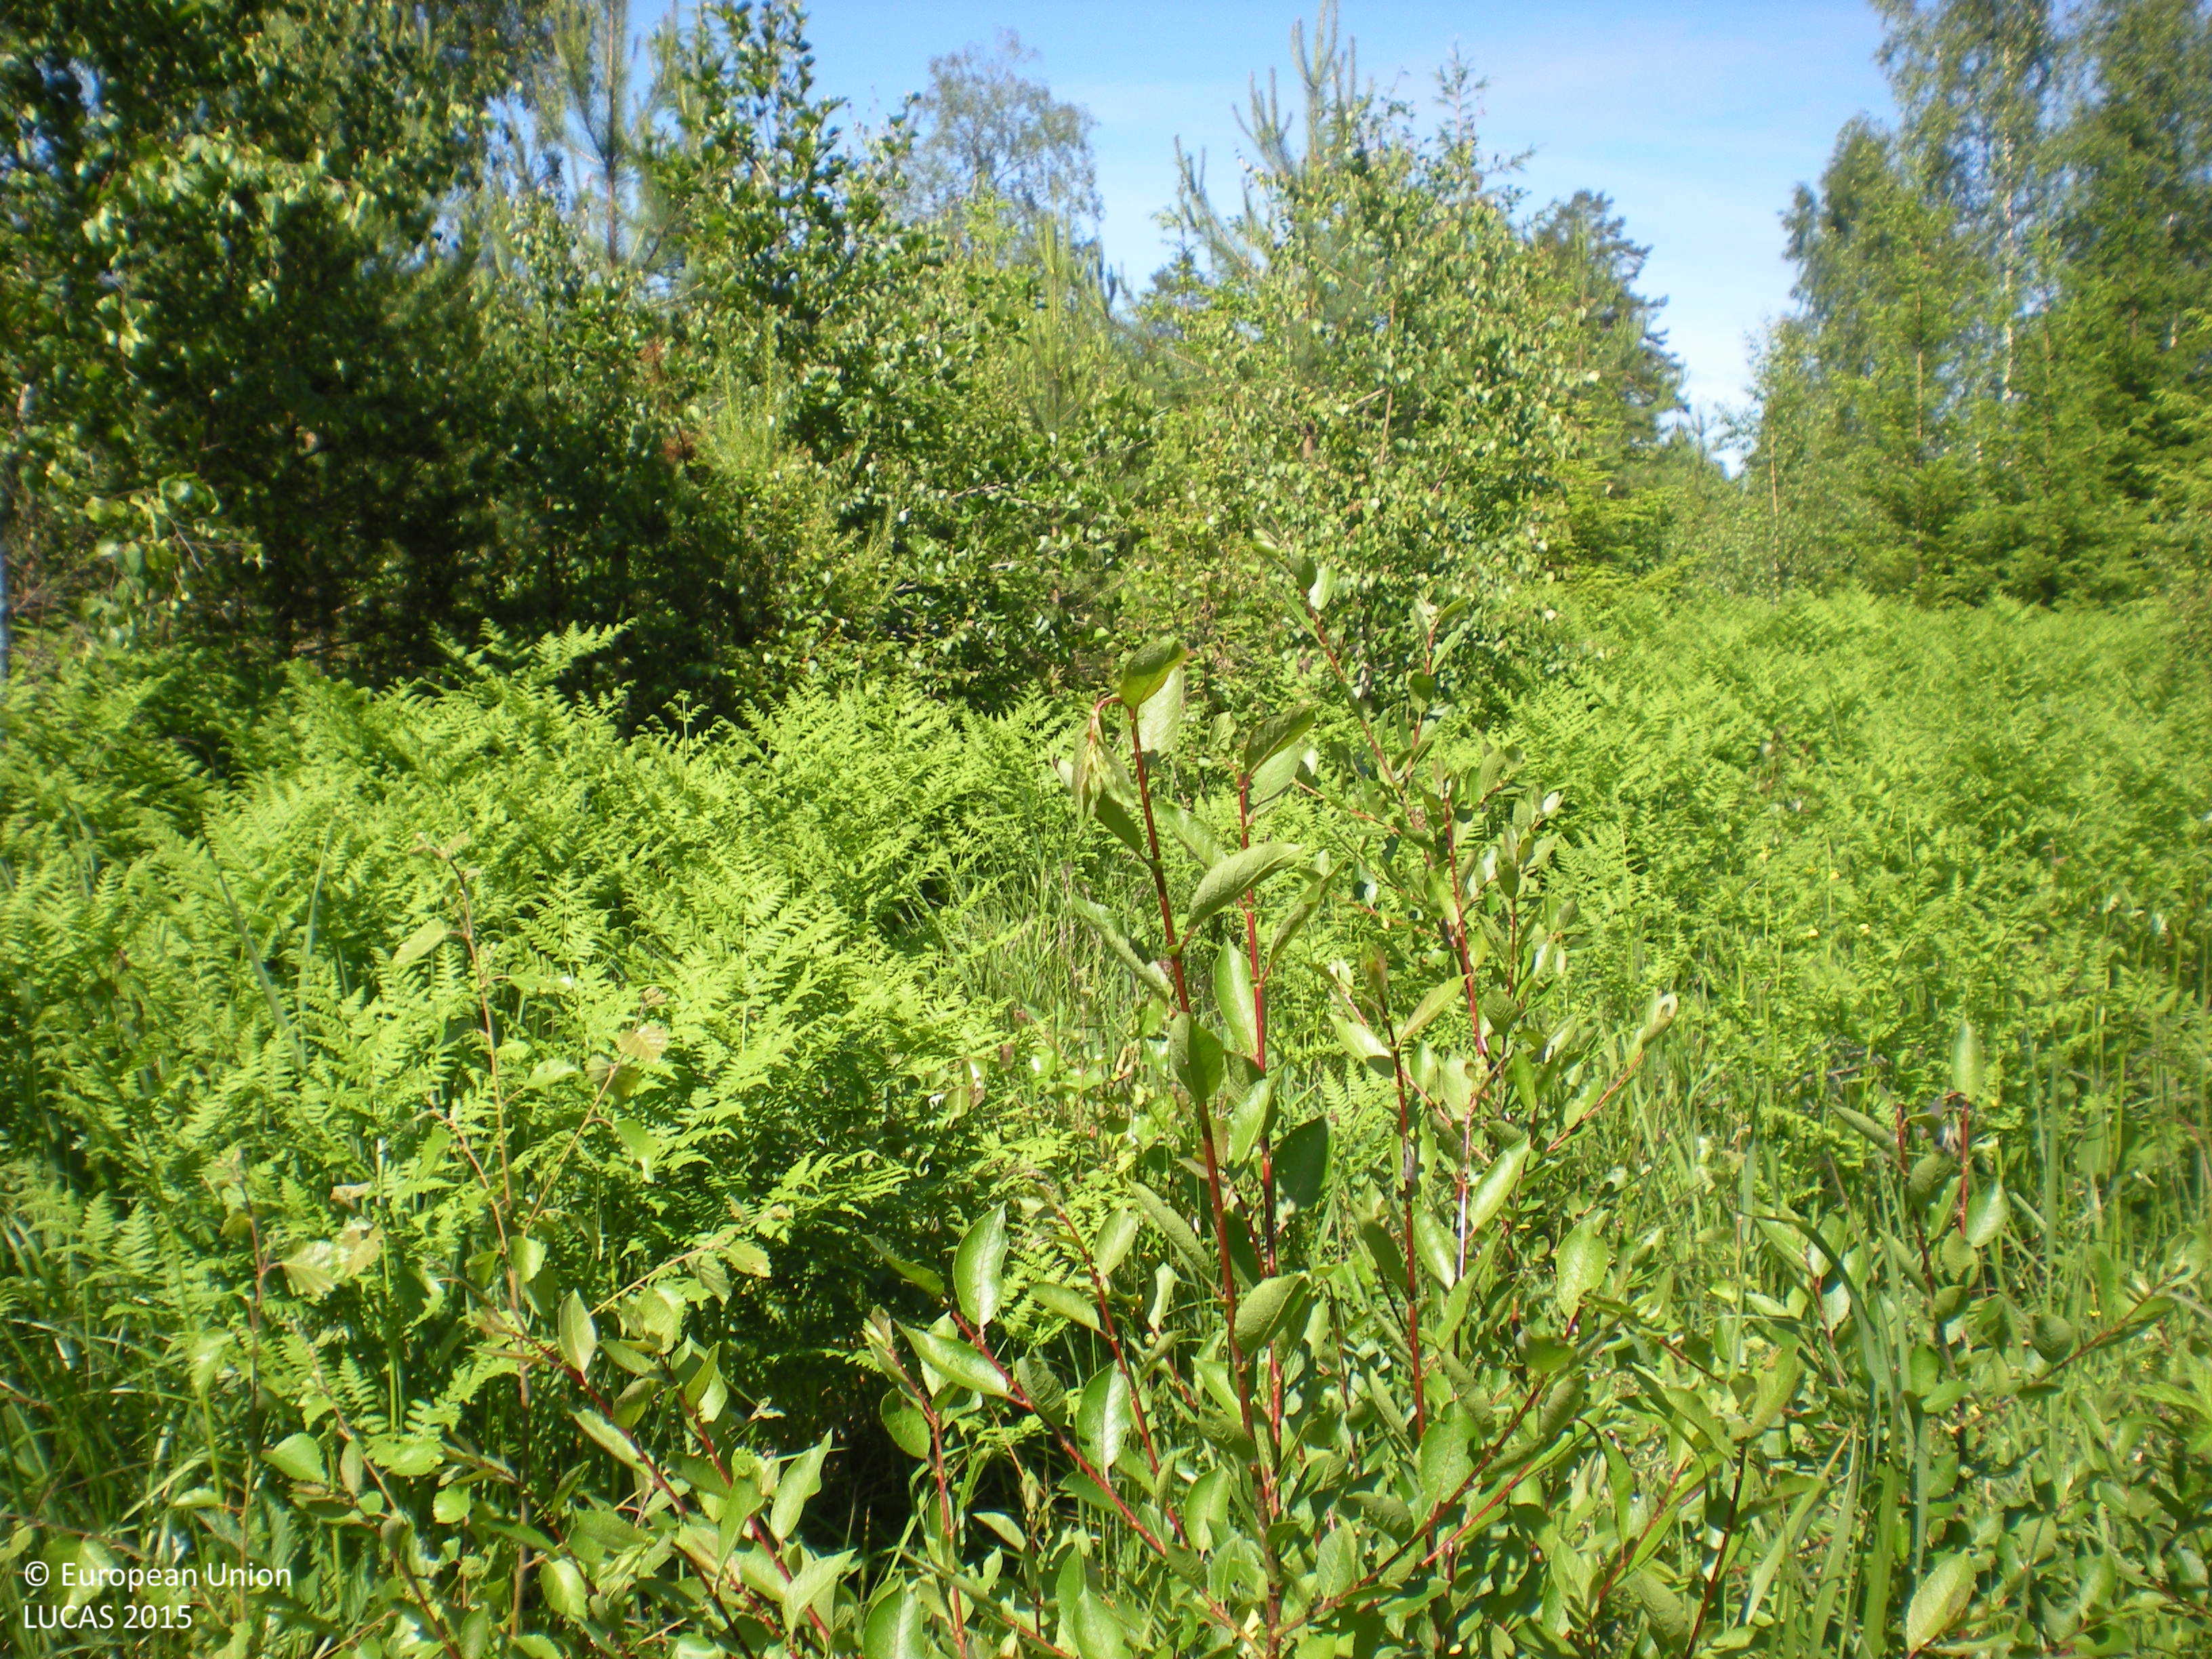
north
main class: Grassland
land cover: Grassland with sparse tree/shrub cover
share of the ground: > 75 %
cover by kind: herbaceous plants 85 %, shrubs 10 %, broadleaved forest trees 5 %
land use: Electricity, gas and thermal power distribution
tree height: < 5 m
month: July
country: SE
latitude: 60.5909
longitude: 17.9336
